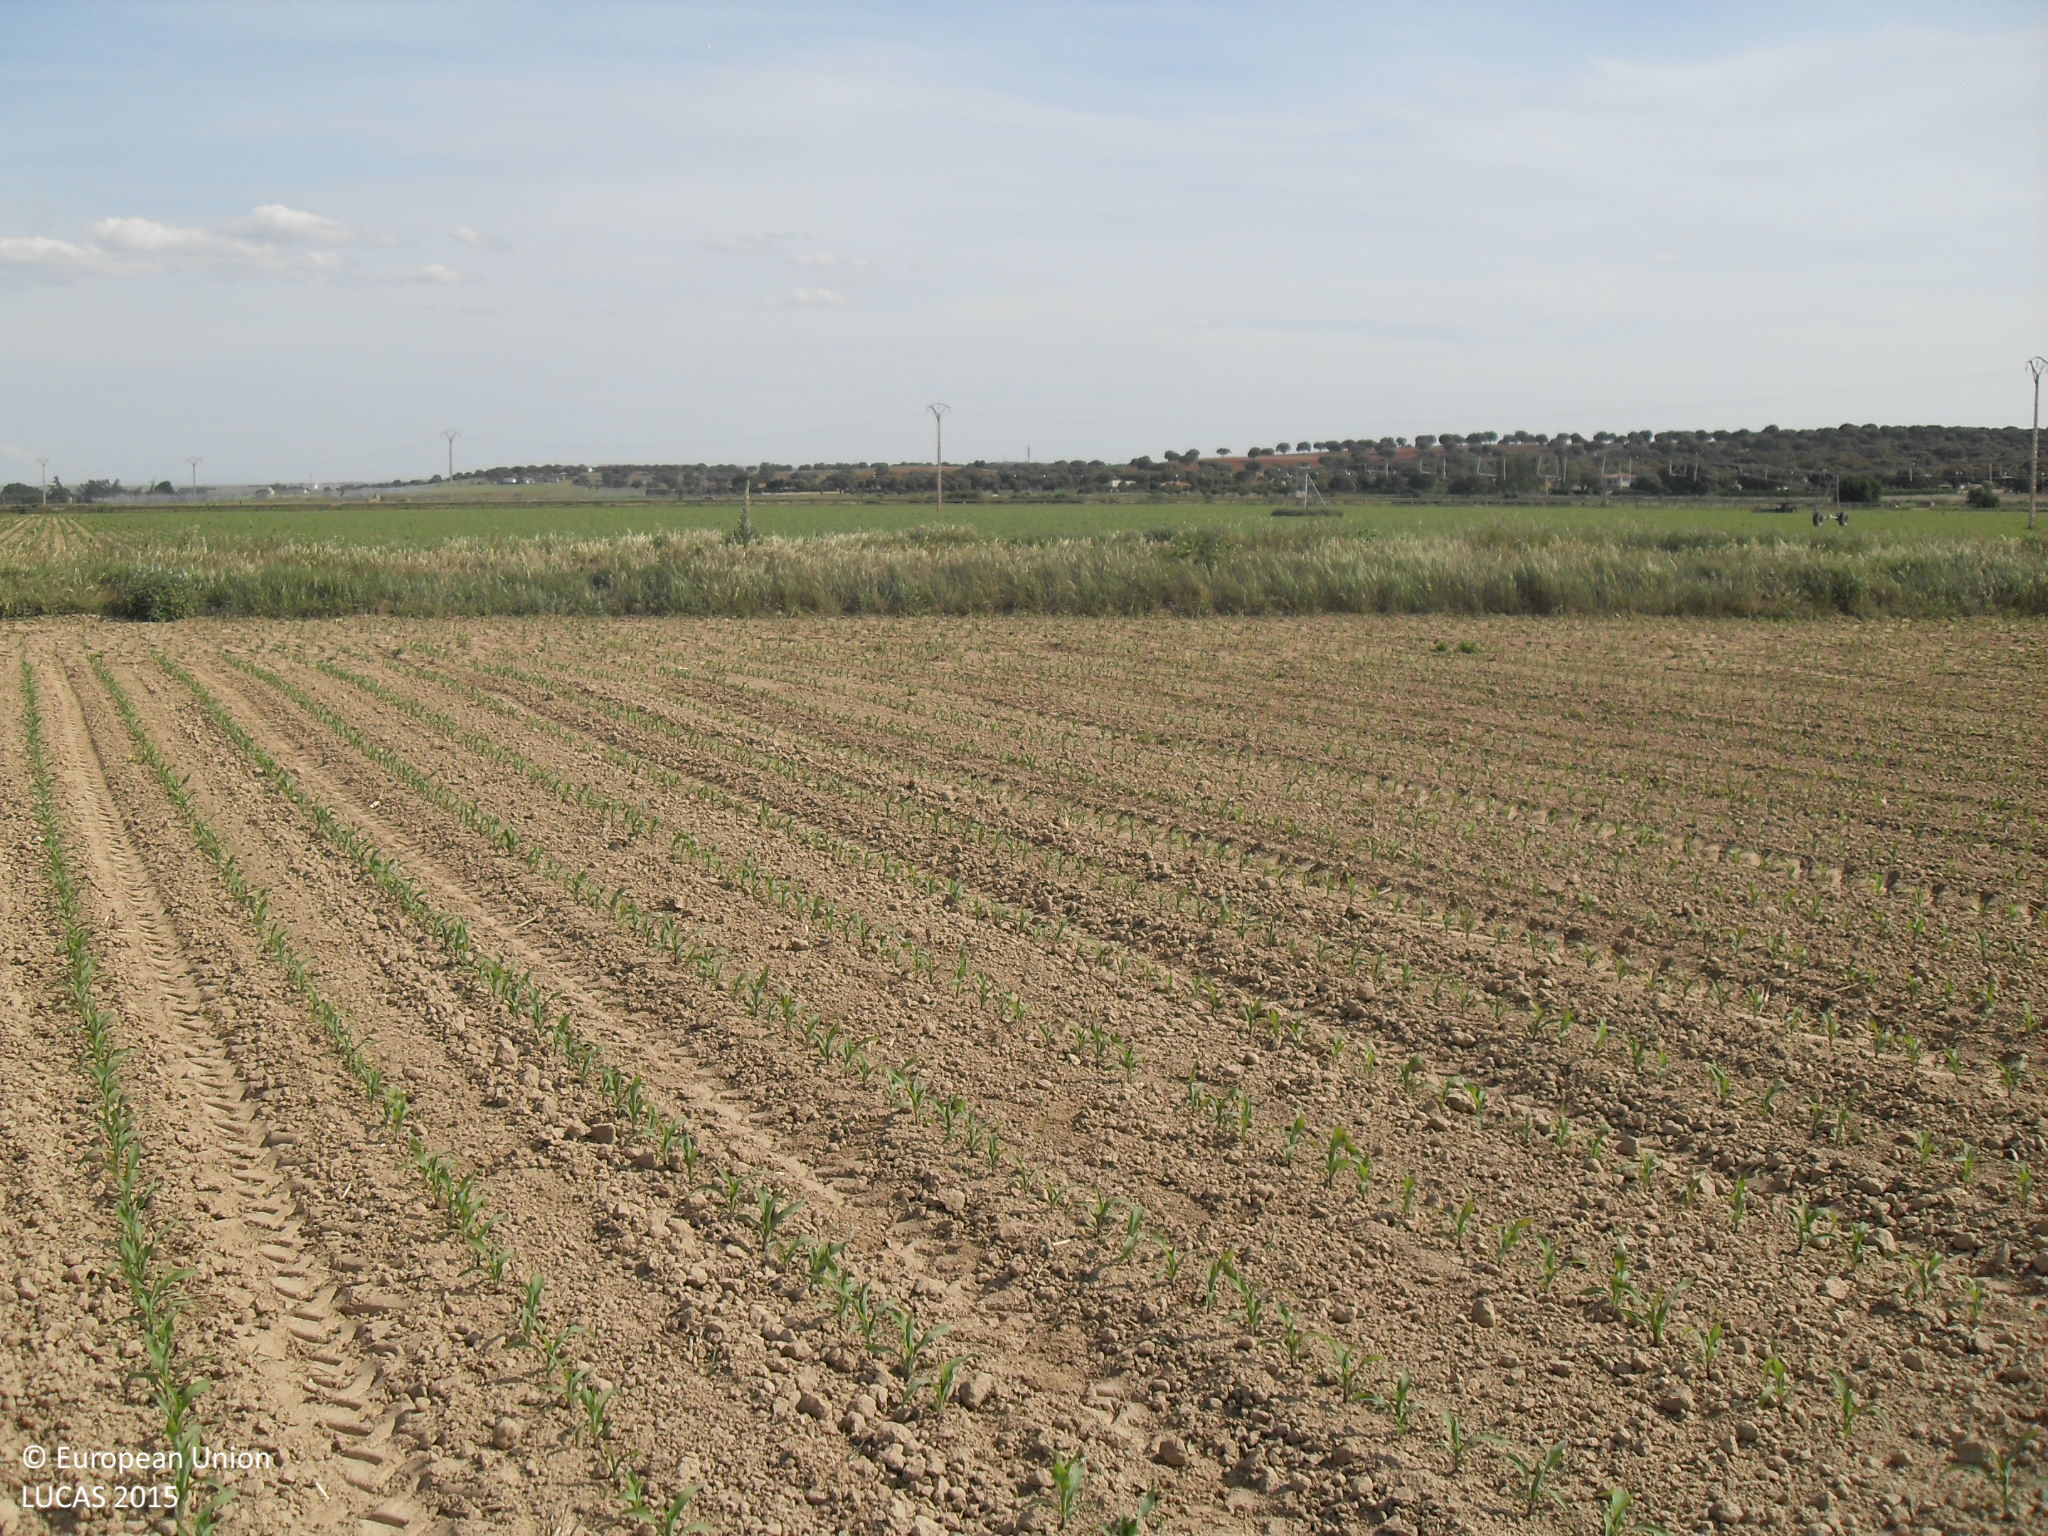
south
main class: Cropland
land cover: Maize
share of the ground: < 10 %
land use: Agriculture (excluding fallow land and kitchen gardens)
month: May
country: ES
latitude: 41.0280
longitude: -5.7435
